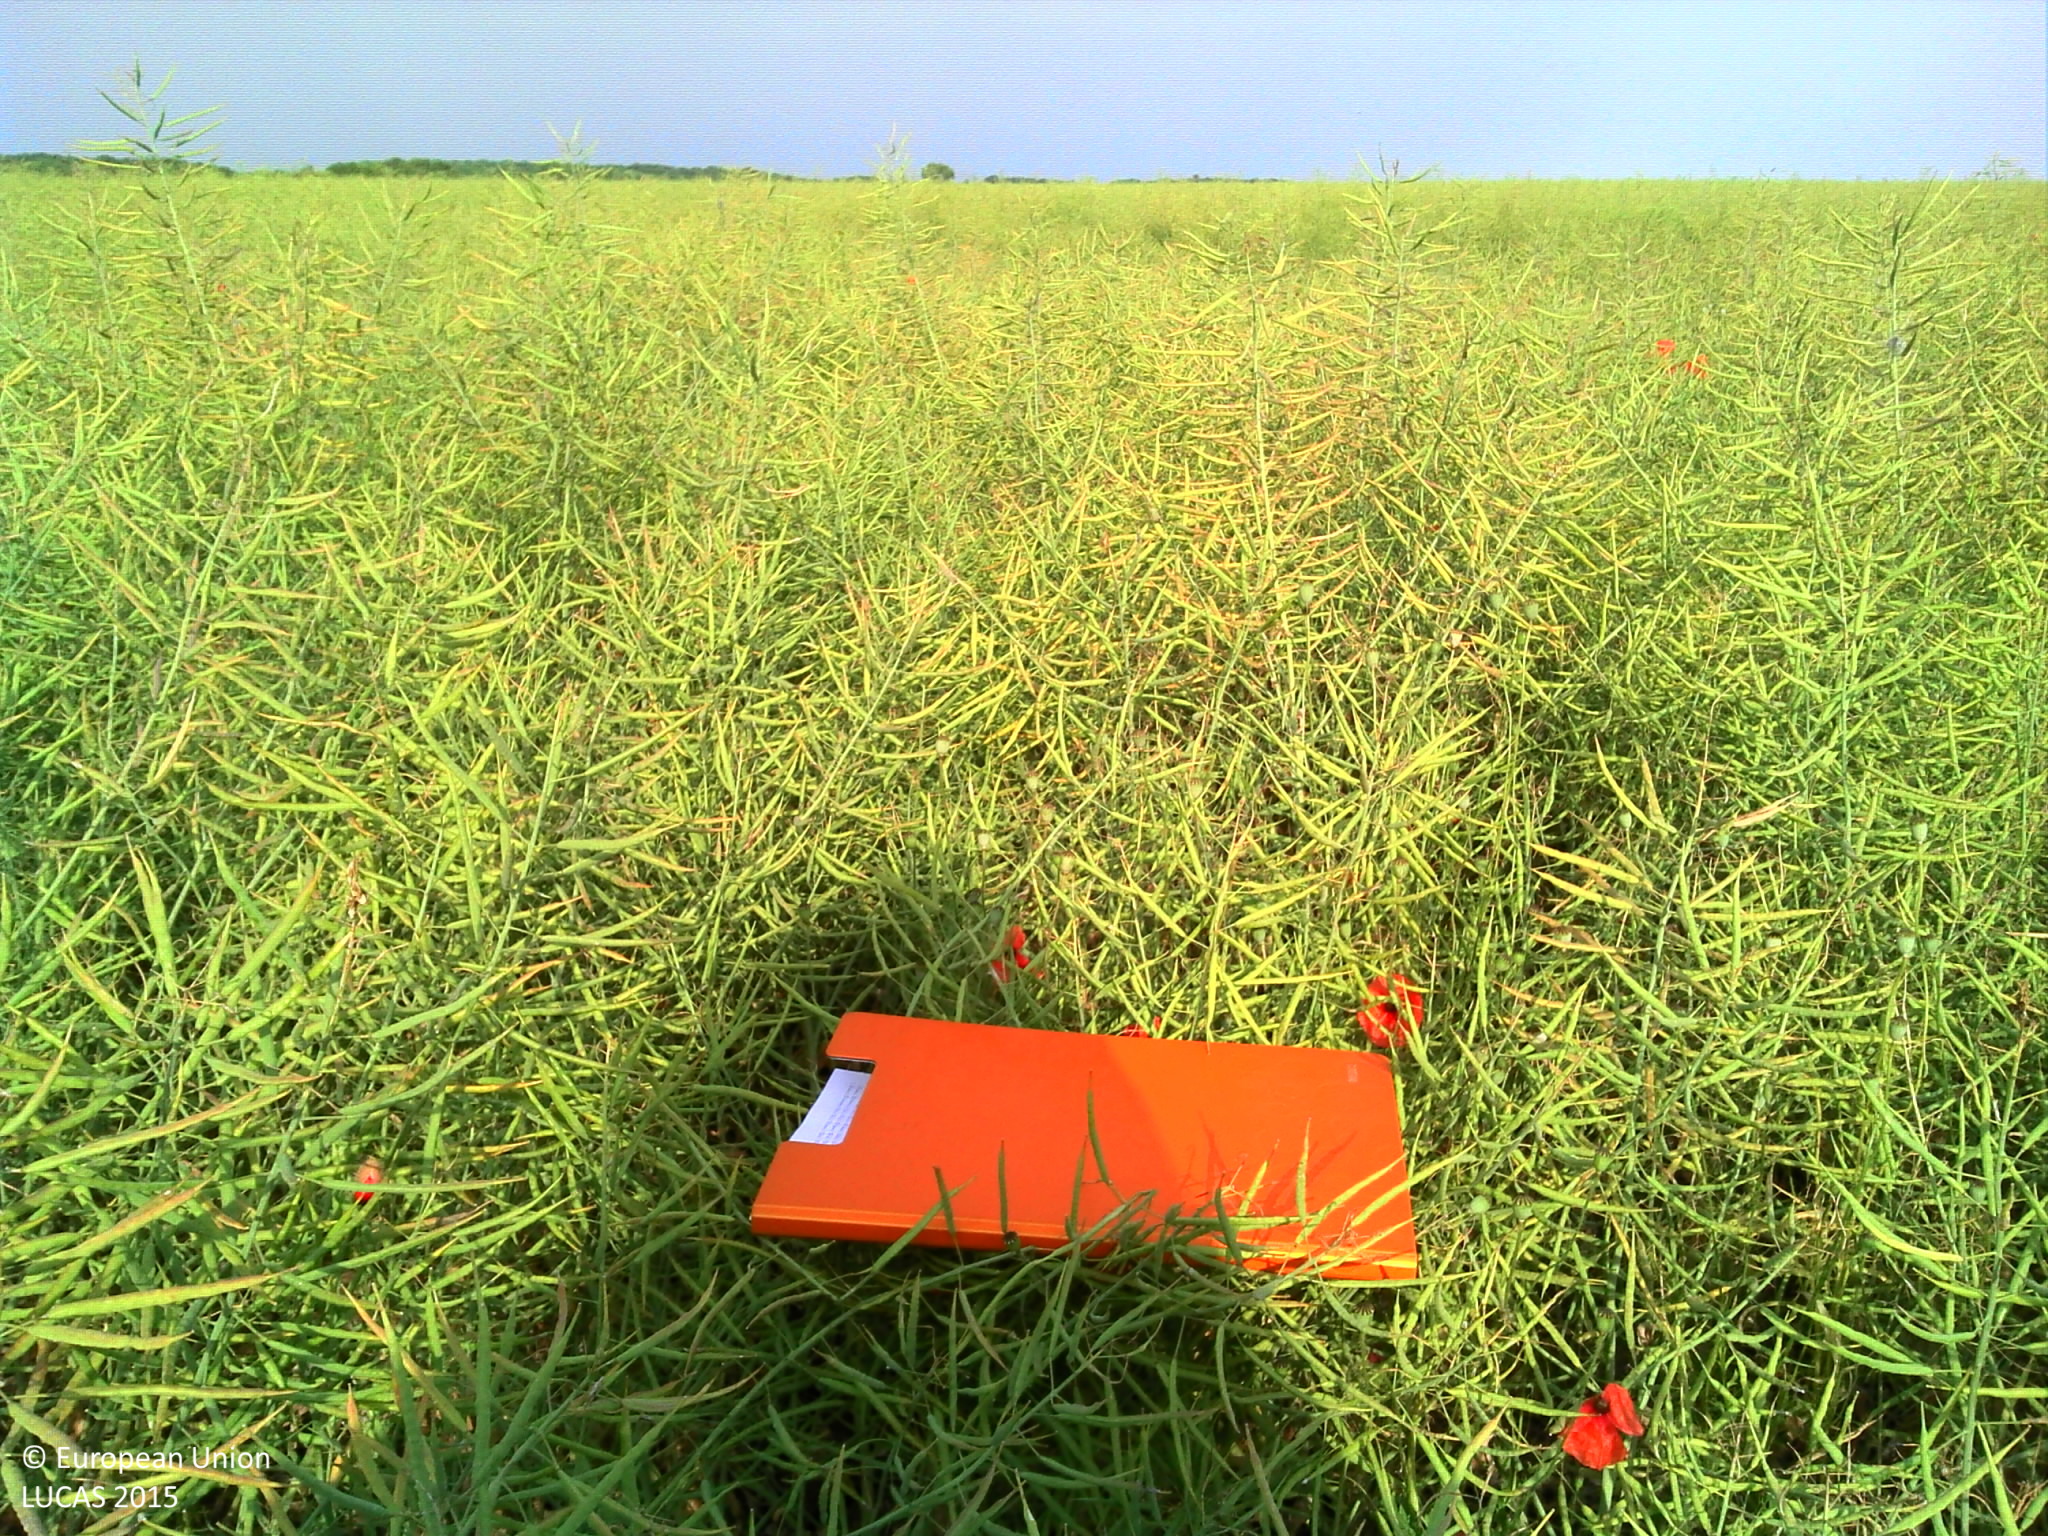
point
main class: Cropland
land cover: Rape and turnip rape
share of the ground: > 75 %
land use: Agriculture (excluding fallow land and kitchen gardens)
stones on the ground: < 10 %
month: June
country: FR
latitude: 46.9103
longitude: 2.6288
